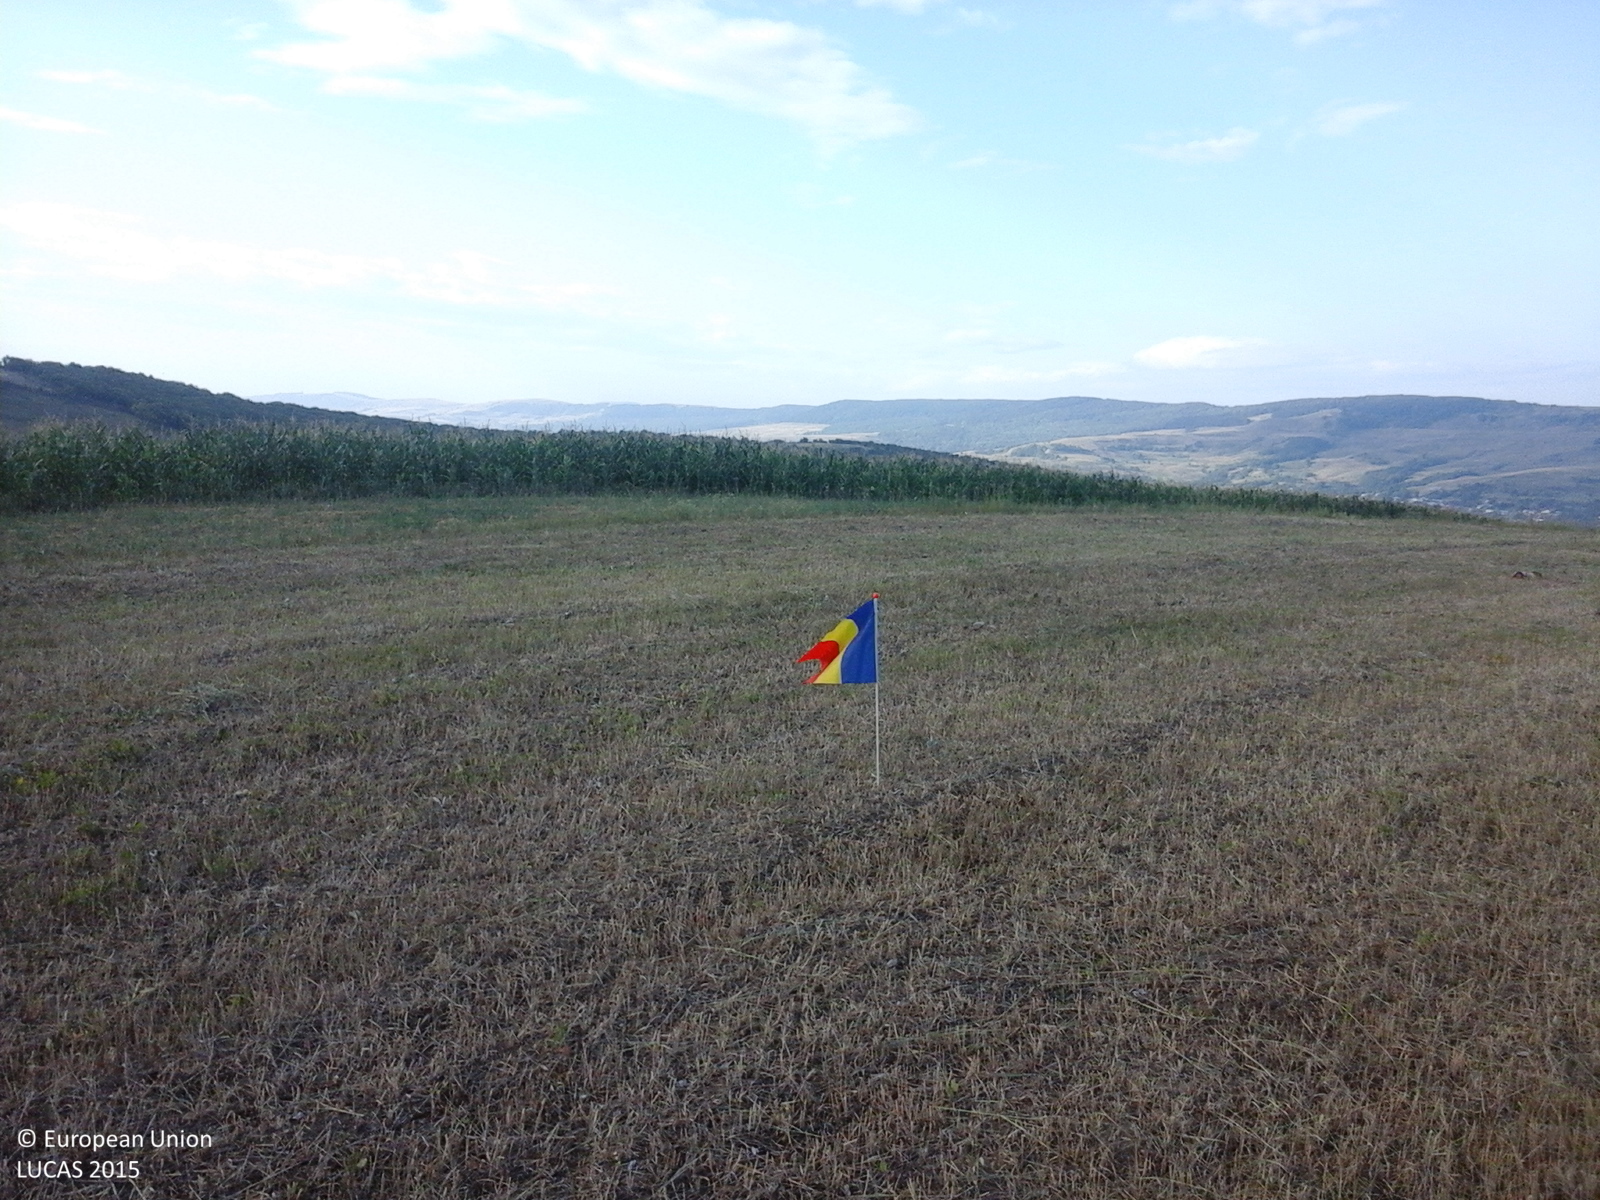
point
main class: Grassland
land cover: Grassland without tree/shrub cover
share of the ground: > 75 %
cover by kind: herbaceous plants 100 %
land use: Agriculture (excluding fallow land and kitchen gardens)
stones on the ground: < 10 %
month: July
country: RO
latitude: 46.7066
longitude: 27.2255
